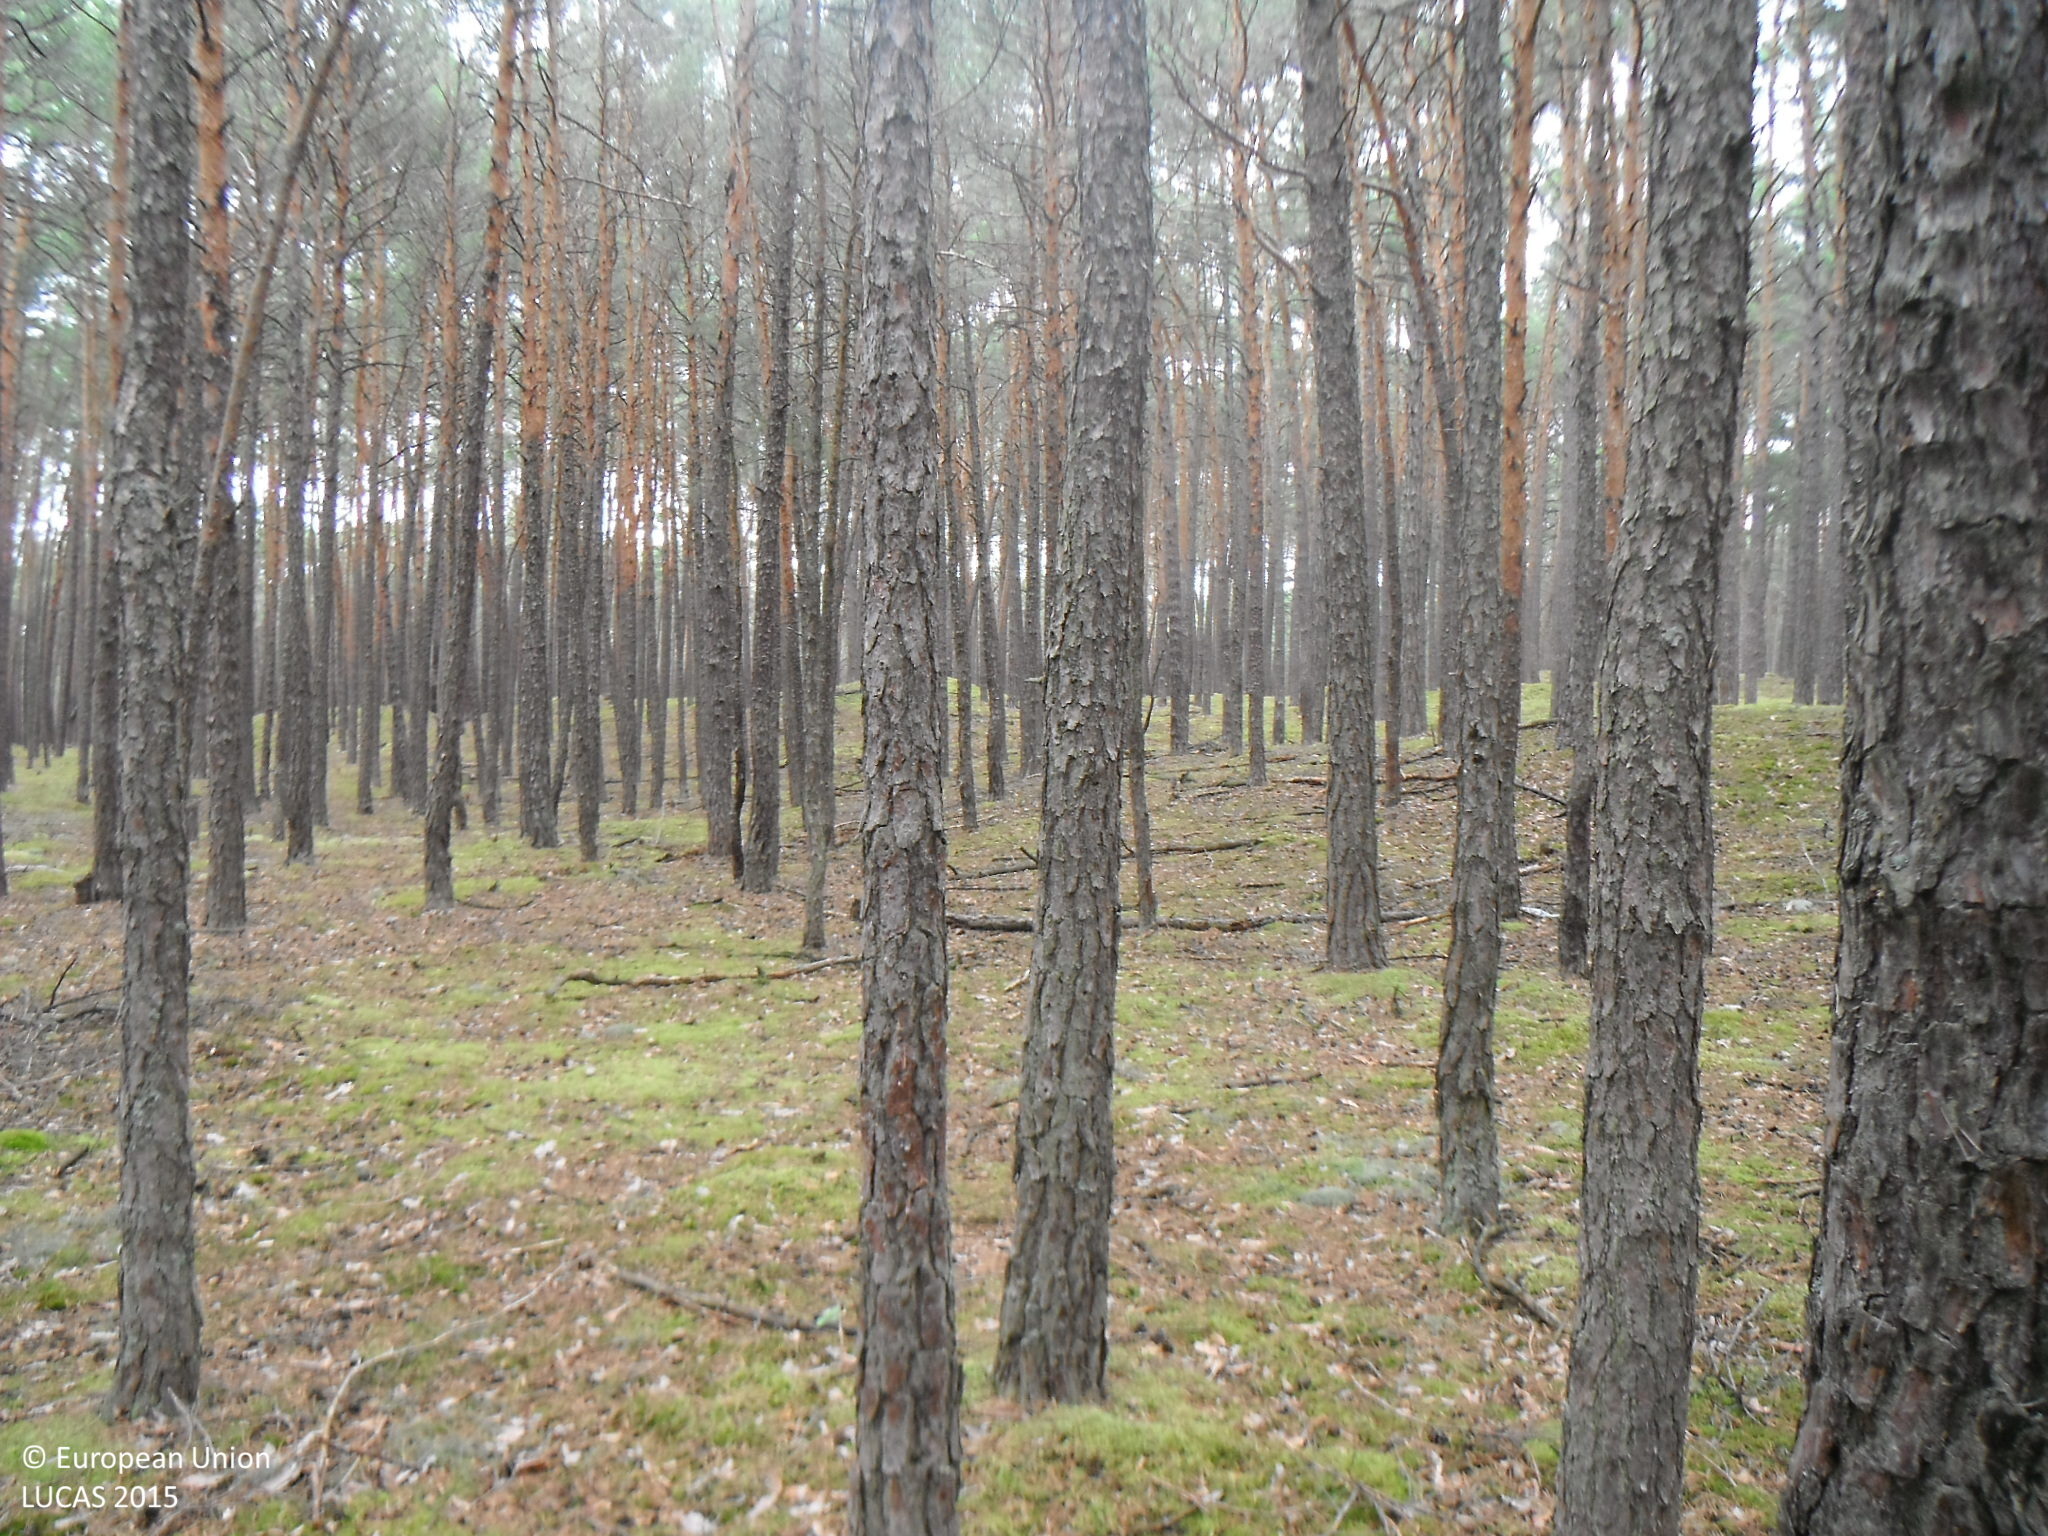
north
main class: Woodland
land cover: Pine dominated coniferous woodland
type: hemiboreal forest and nemoral coniferous forest and mixed broadleaved-coniferous forest
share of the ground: > 75 %
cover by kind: coniferous forest trees 80 %, lichens and mosses 20 %
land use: Forestry
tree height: > 5 m
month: June
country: SK
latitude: 48.6355
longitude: 17.2423
